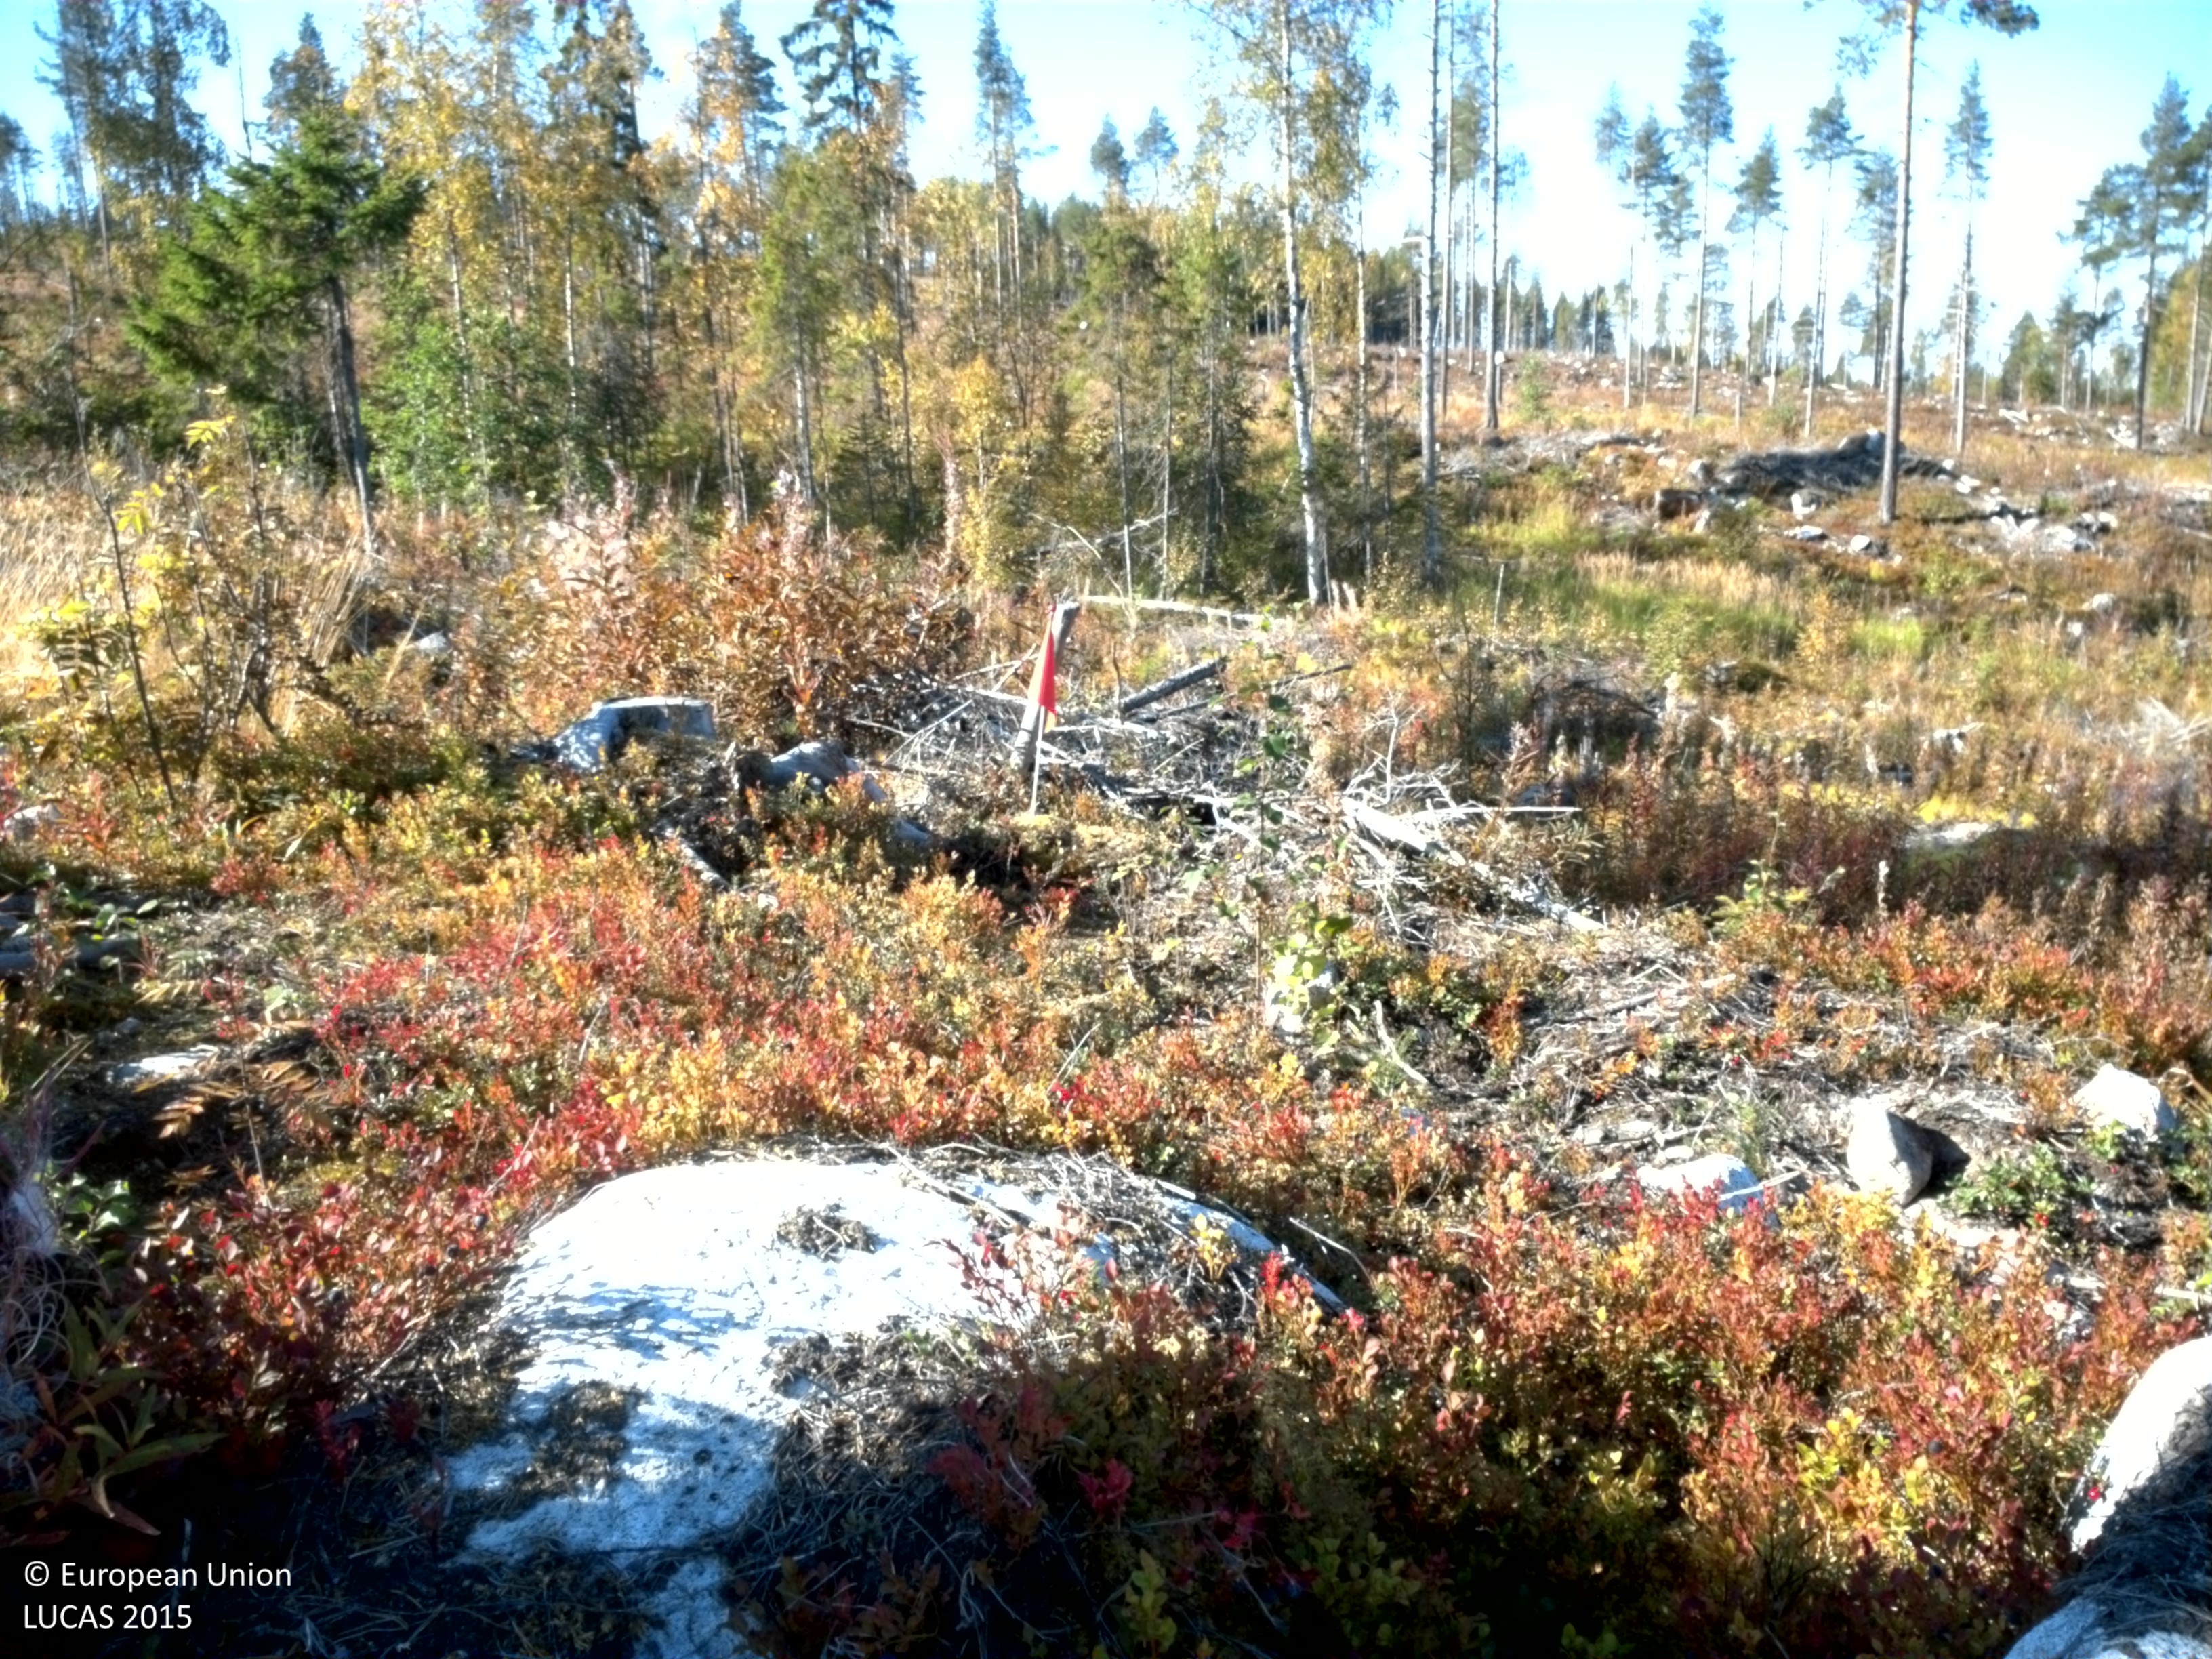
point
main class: Shrubland
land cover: Shrubland with sparse tree cover
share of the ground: > 75 %
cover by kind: shrubs 90 %, broadleaved forest trees 5 %, consolidated bare surface 5 %
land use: Forestry
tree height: < 5 m
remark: Clear cut
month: September
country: SE
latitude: 65.9118
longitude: 22.1178
